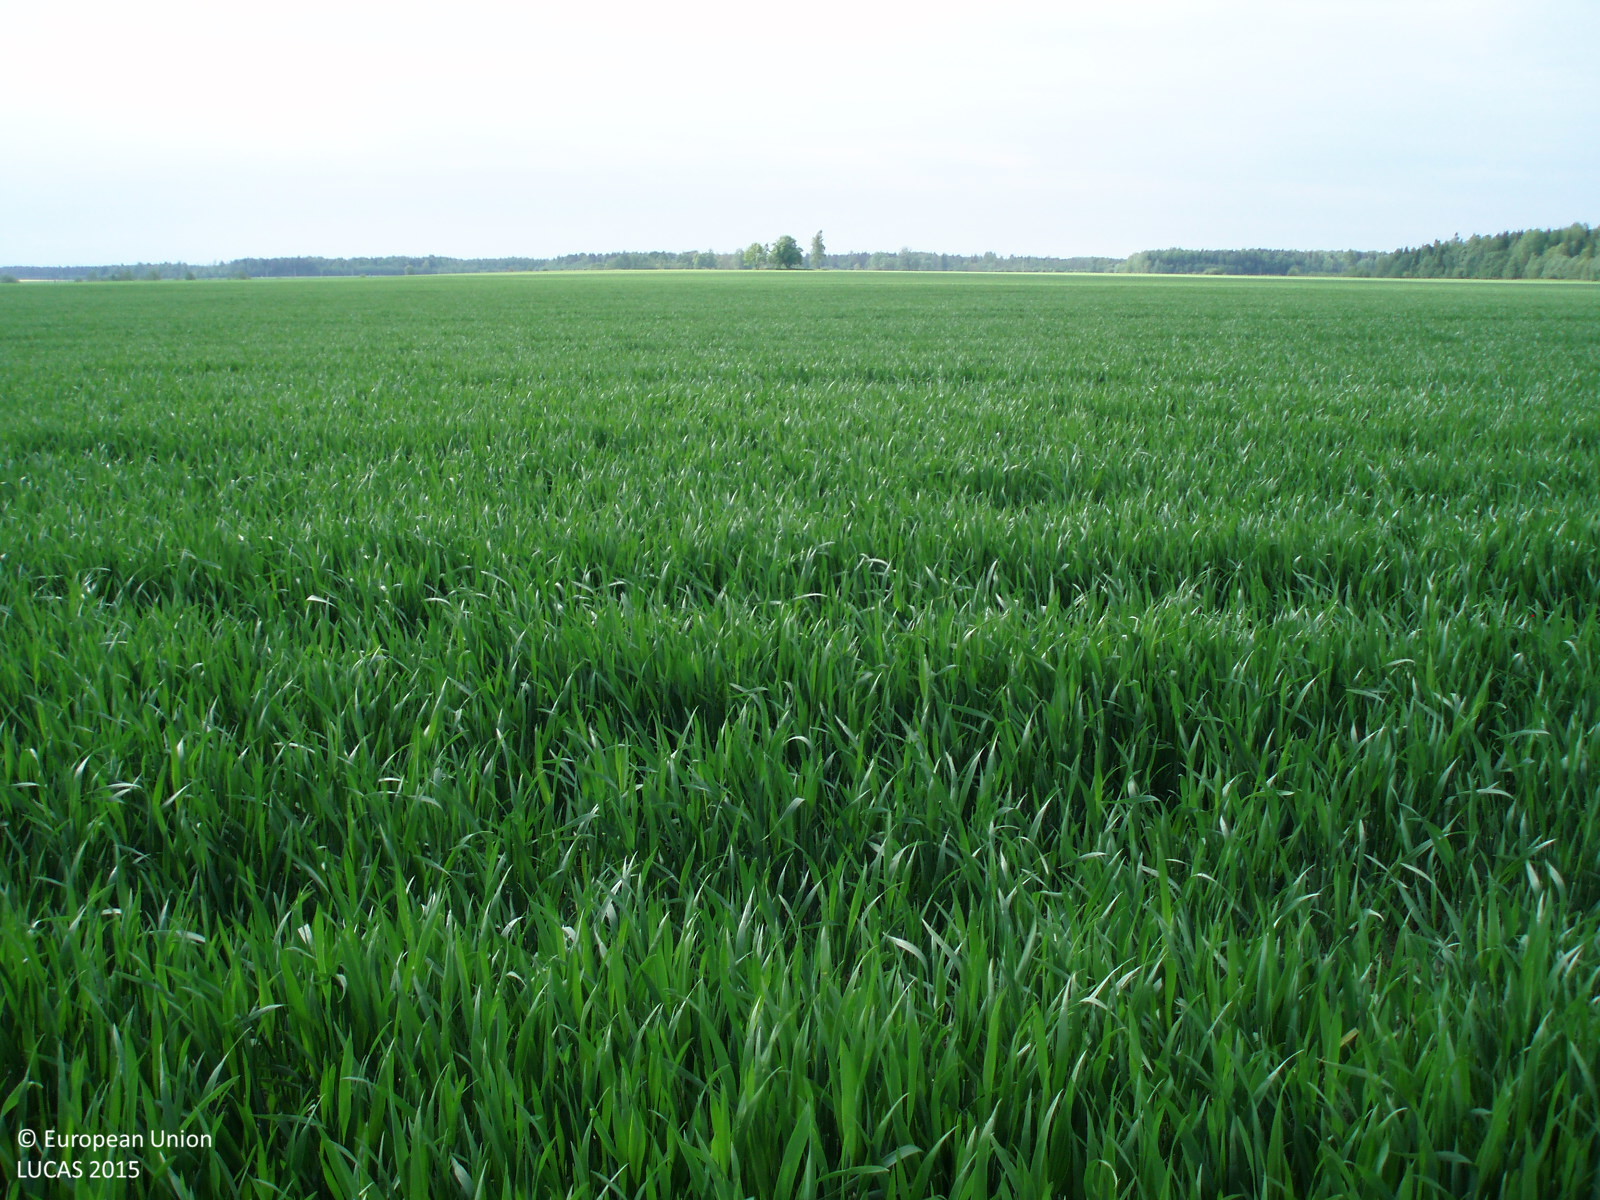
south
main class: Cropland
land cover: Common wheat
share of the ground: > 75 %
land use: Agriculture (excluding fallow land and kitchen gardens)
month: May
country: LT
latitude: 56.1831
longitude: 22.4143
